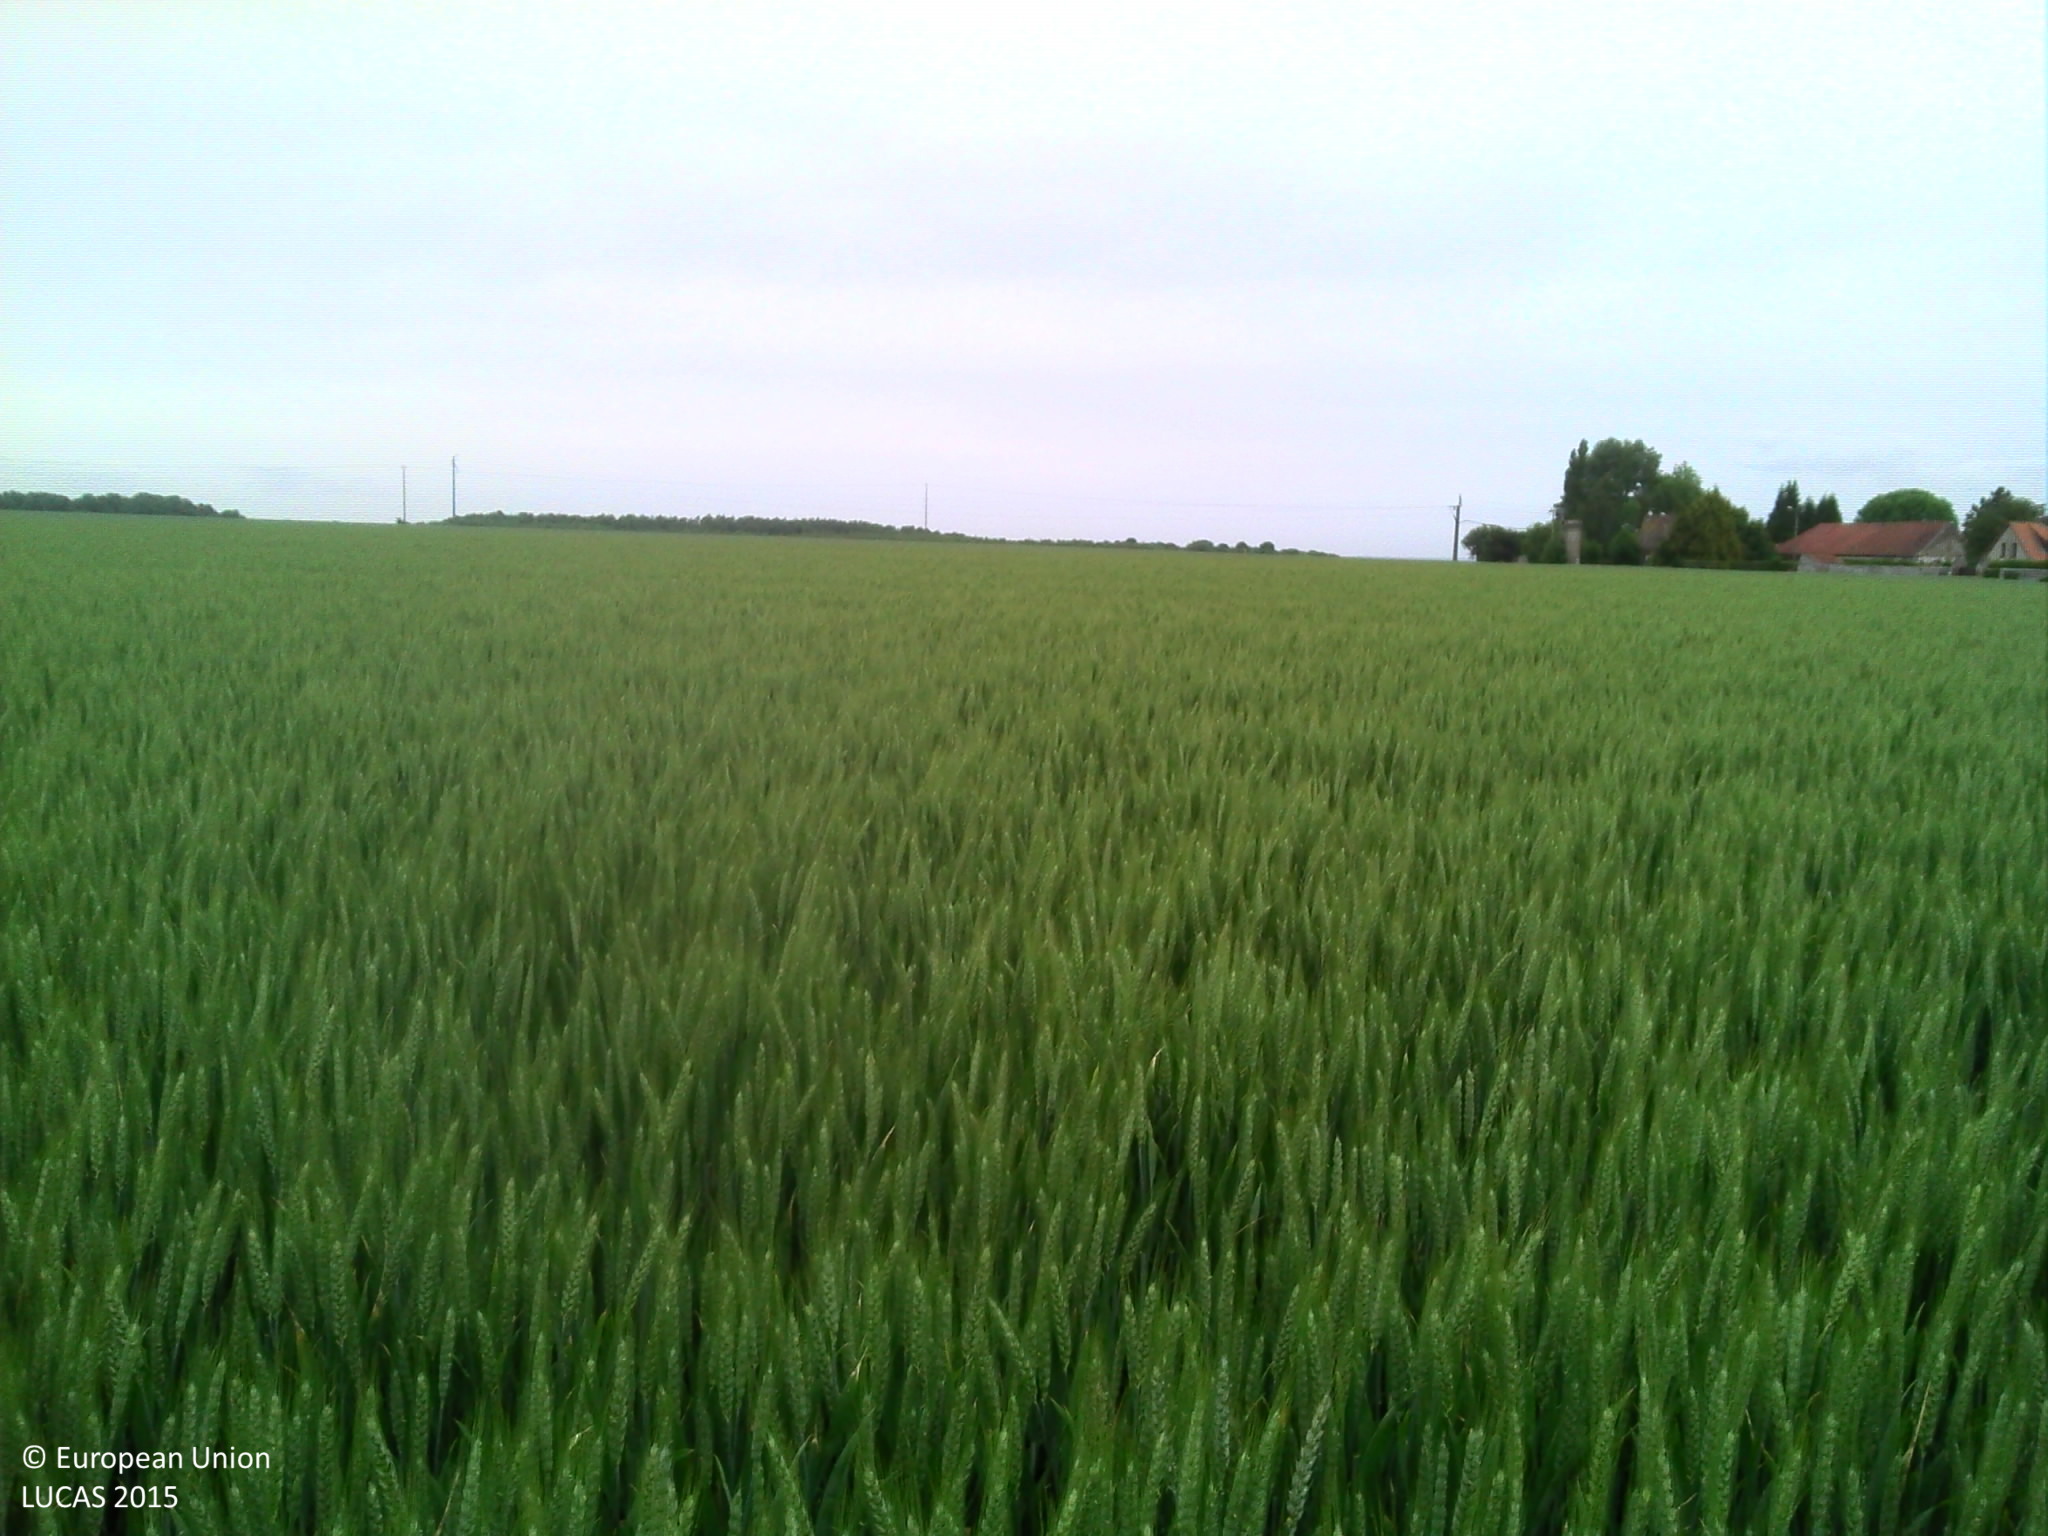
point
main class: Cropland
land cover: Durum wheat
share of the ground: > 75 %
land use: Agriculture (excluding fallow land and kitchen gardens)
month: June
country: FR
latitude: 49.8971
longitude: 2.1759
